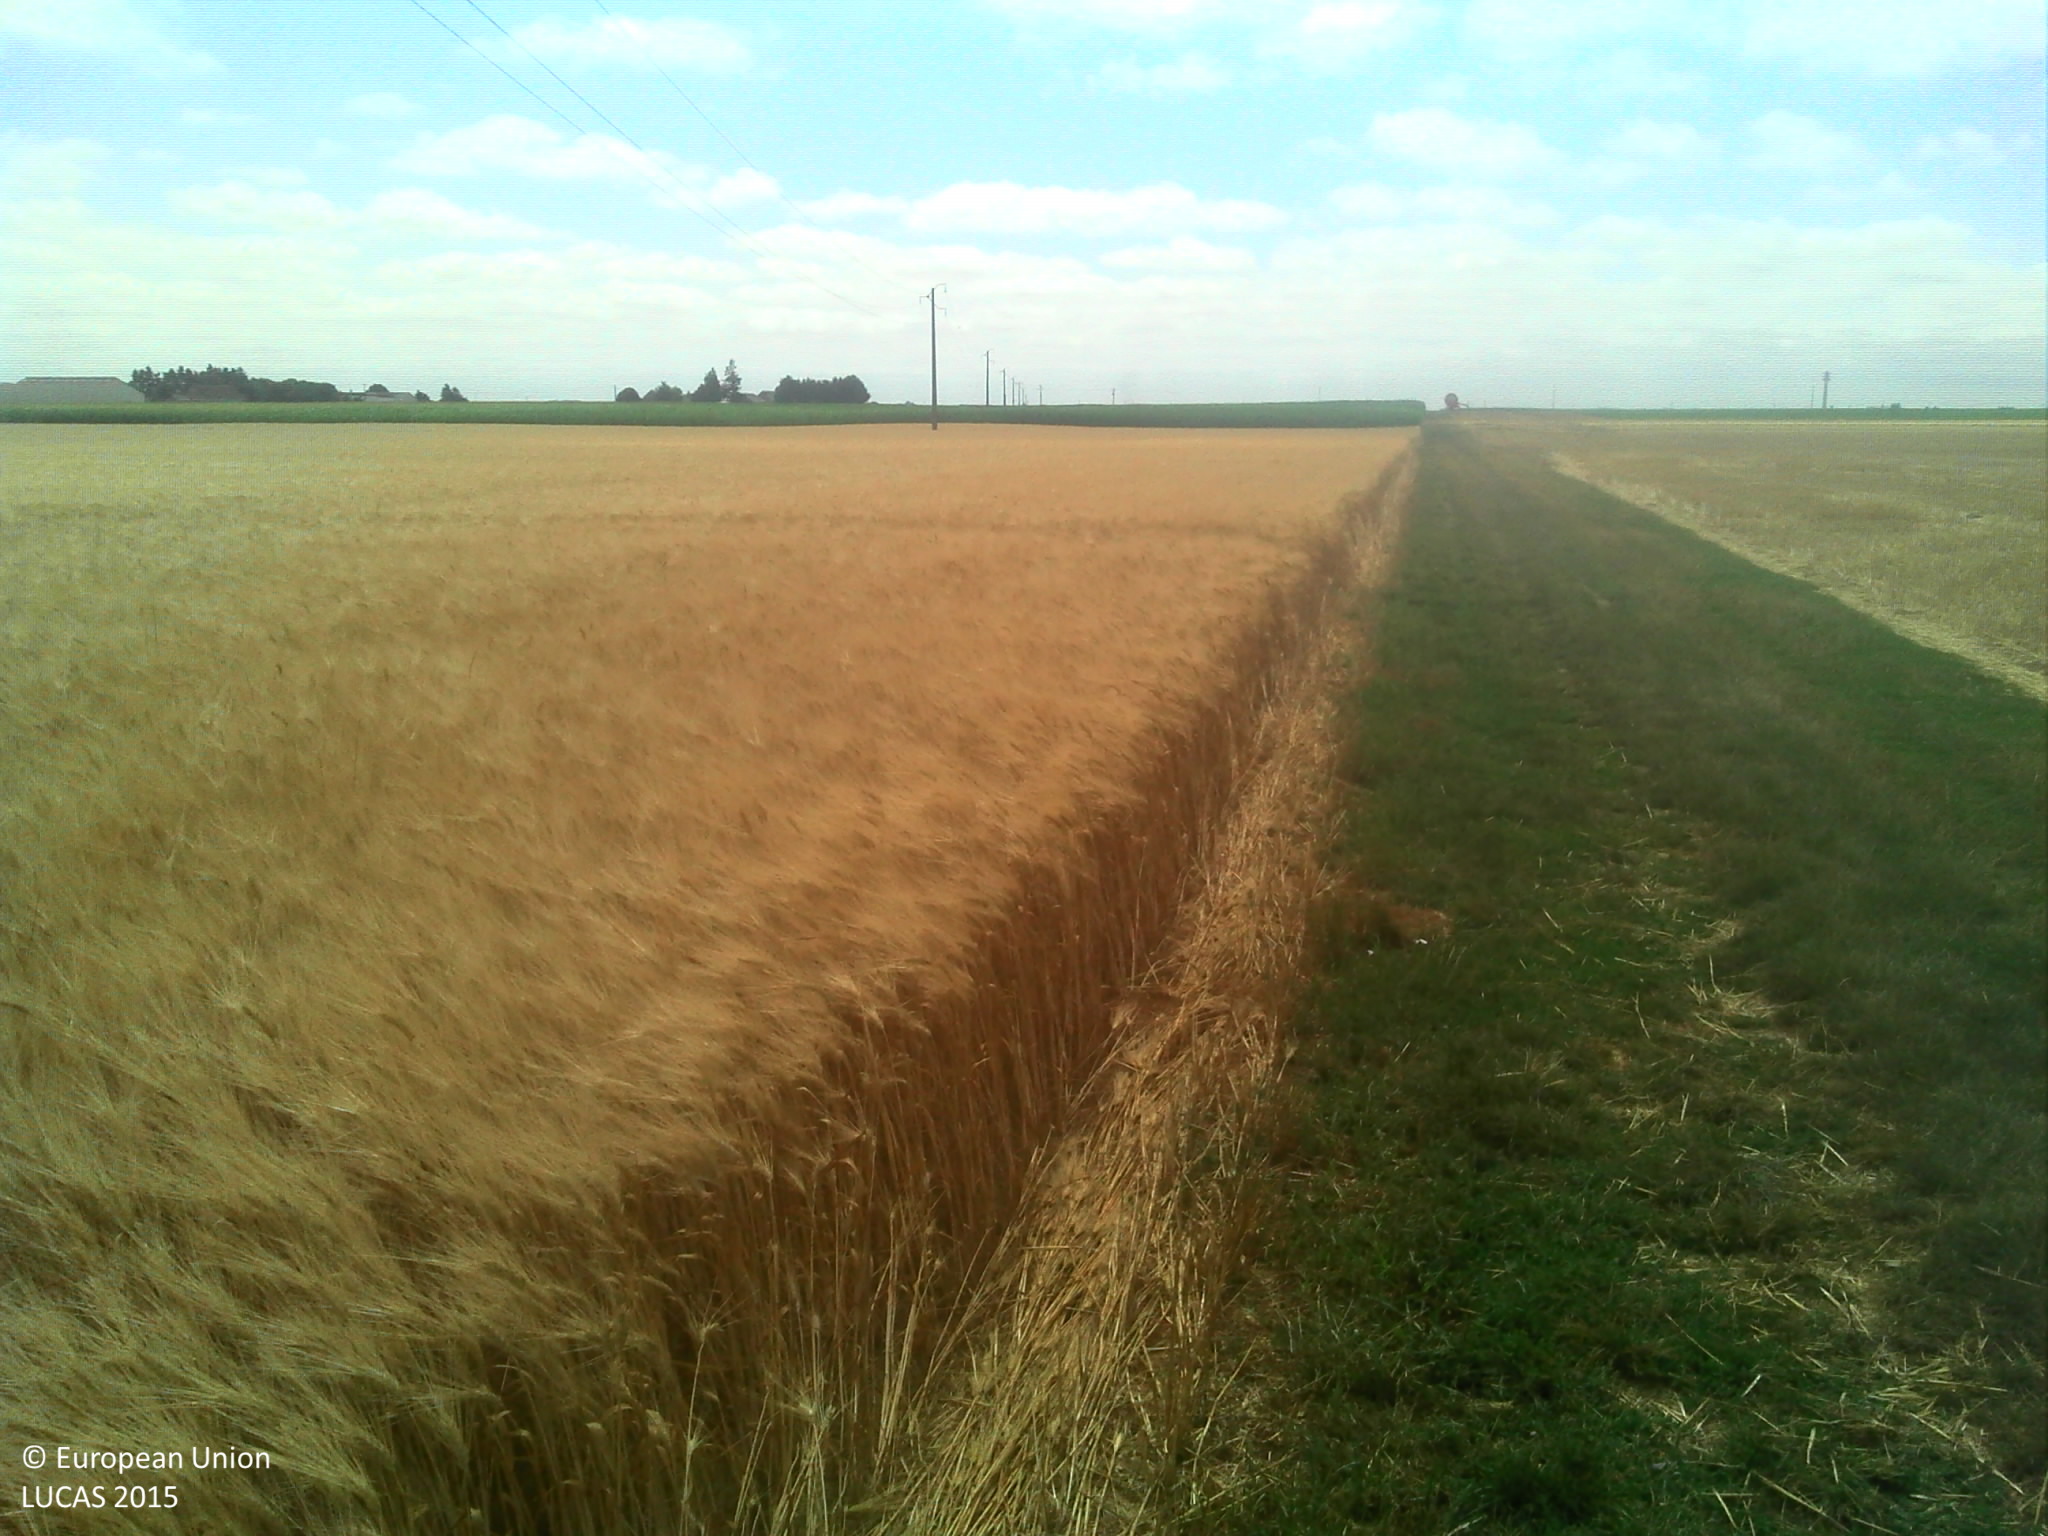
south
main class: Cropland
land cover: Durum wheat
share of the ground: > 75 %
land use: Agriculture (excluding fallow land and kitchen gardens)
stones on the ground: < 10 %
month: July
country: FR
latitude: 47.8081
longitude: 1.3176
